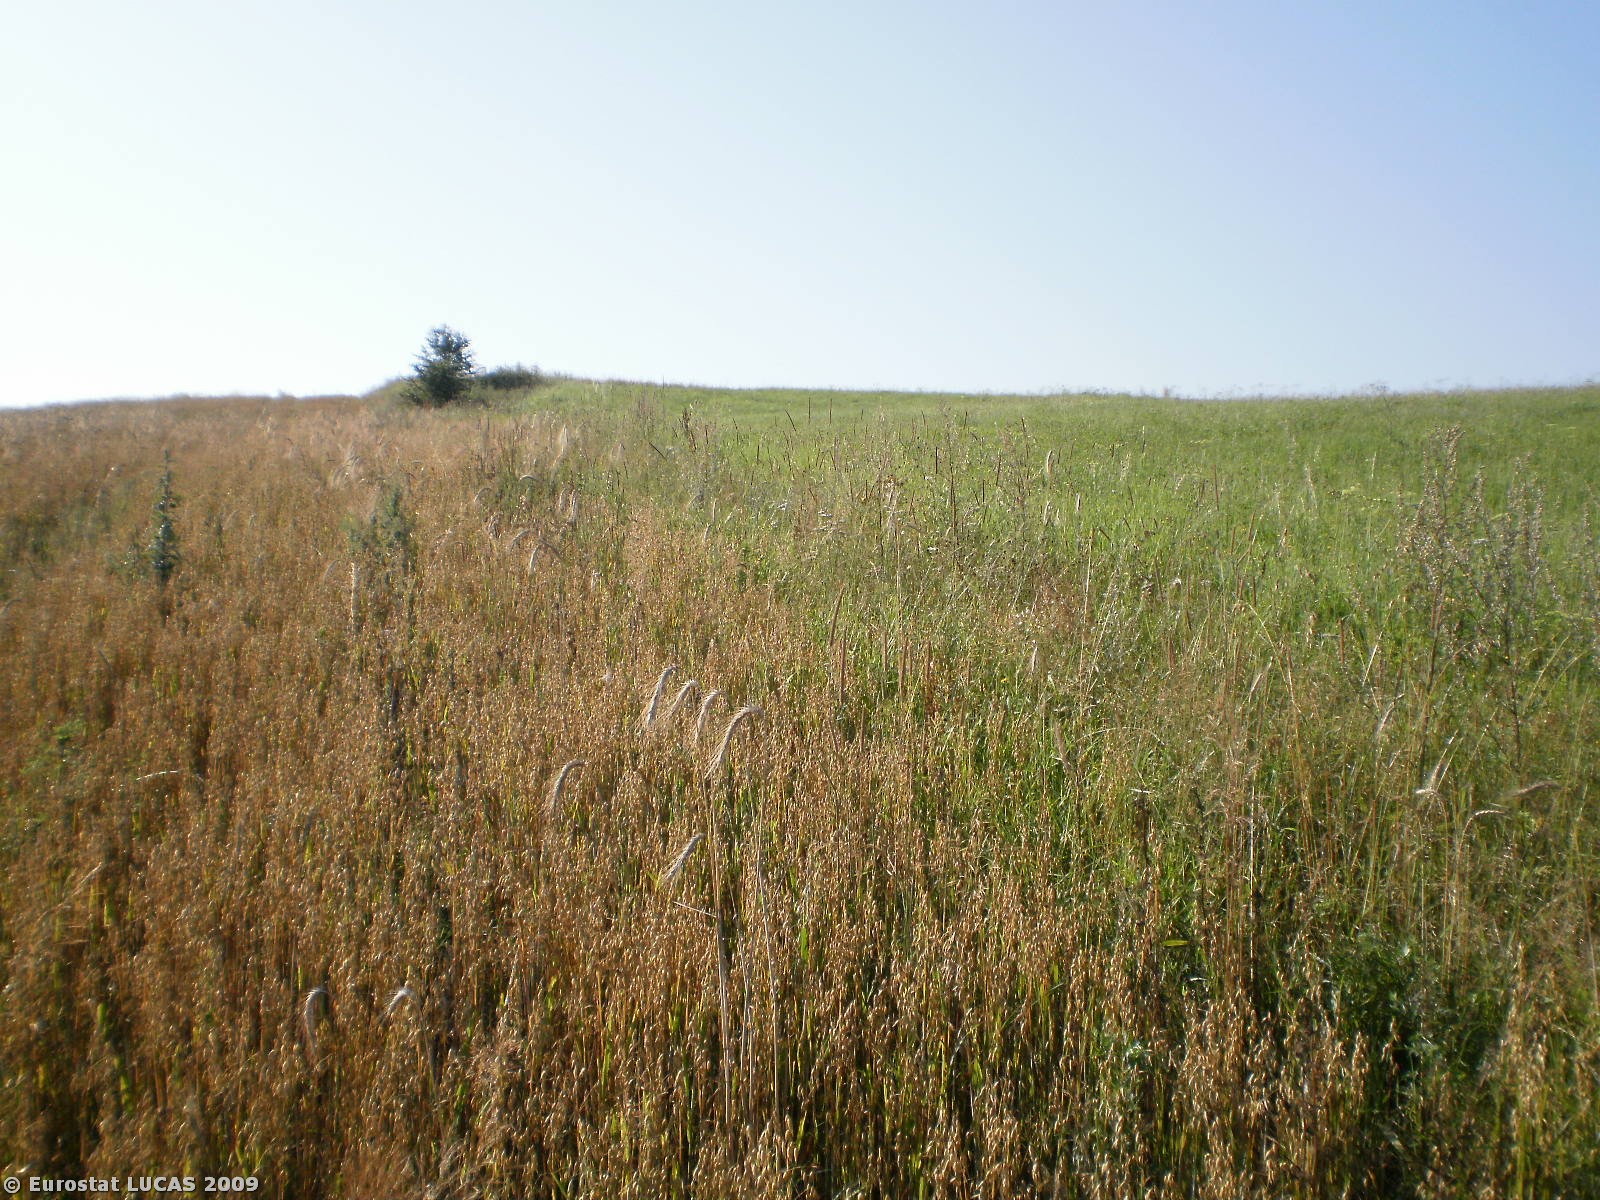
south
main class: Cropland
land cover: Mixed cereals for fodder
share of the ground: > 75 %
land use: Agriculture (excluding fallow land and kitchen gardens)
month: August
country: PL
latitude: 54.0526
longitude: 20.6853
